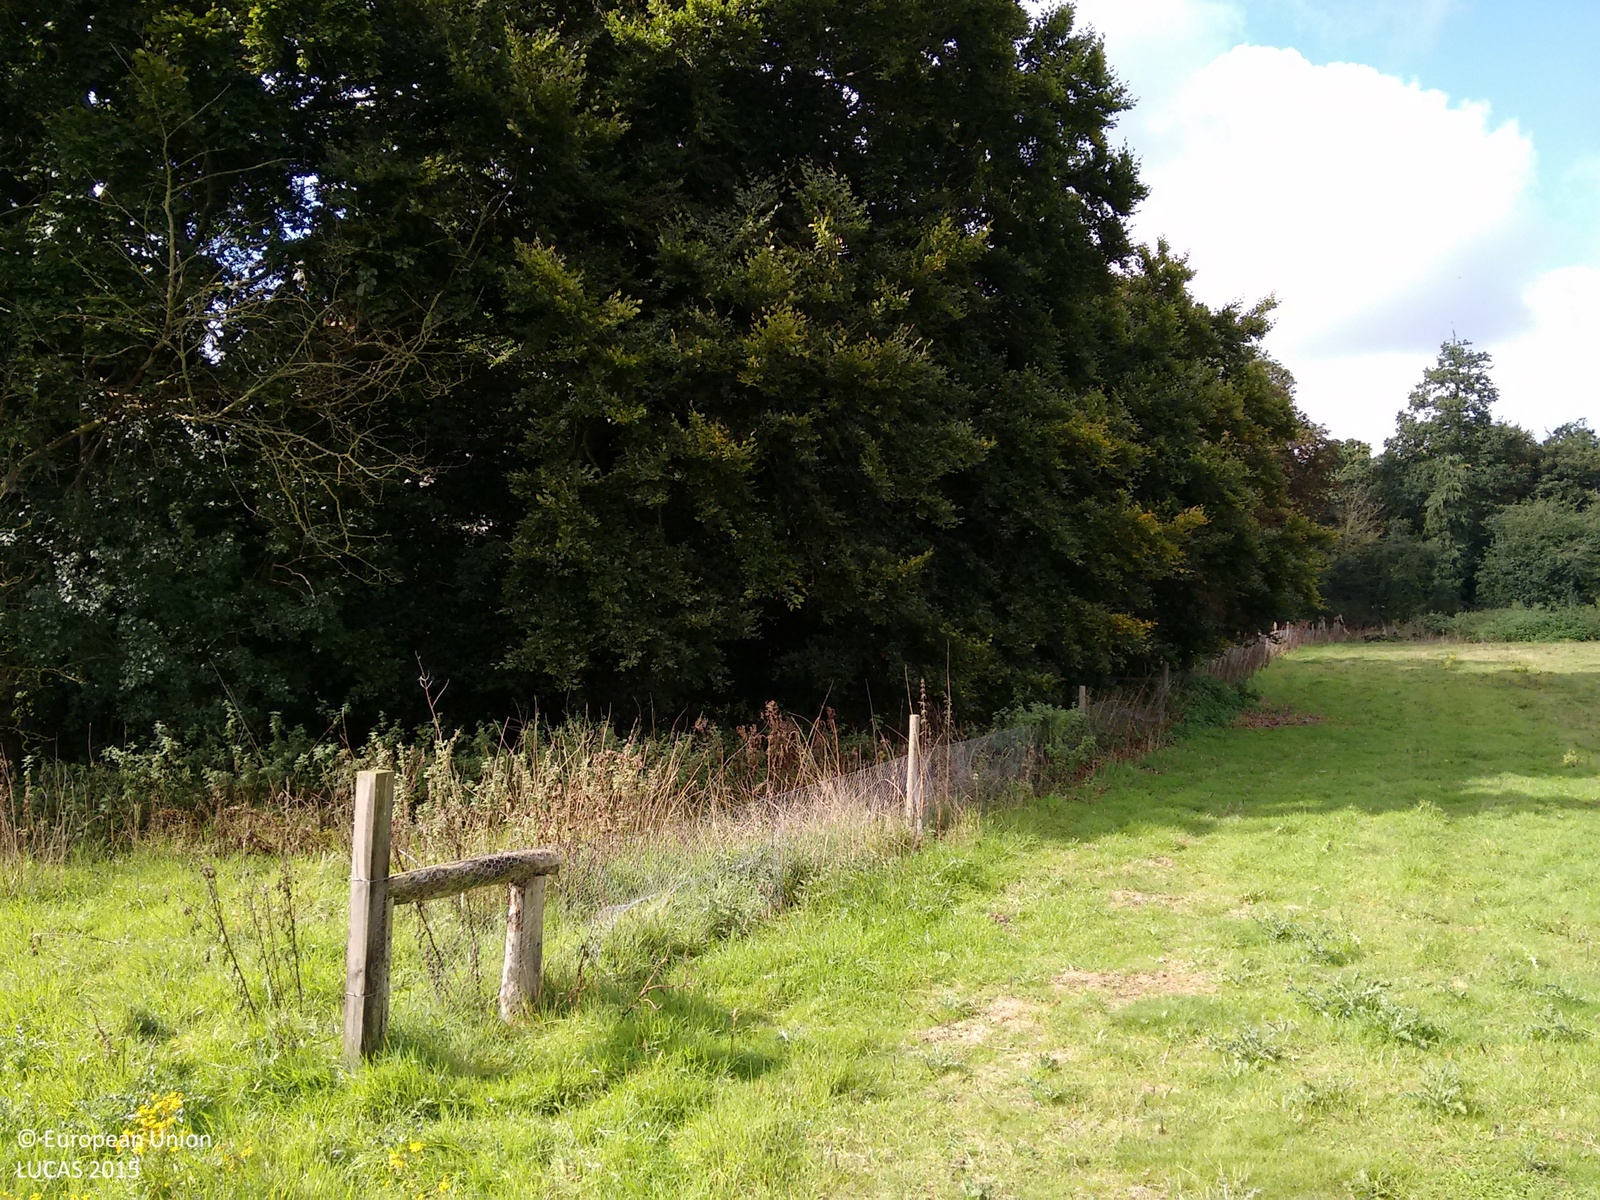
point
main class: Woodland
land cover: Broadleaved woodland
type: mesophytic deciduous forest
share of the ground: > 75 %
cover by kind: broadleaved forest trees 100 %
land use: Forestry
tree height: > 5 m
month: September
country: GB
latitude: 52.5404
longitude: 1.4733
